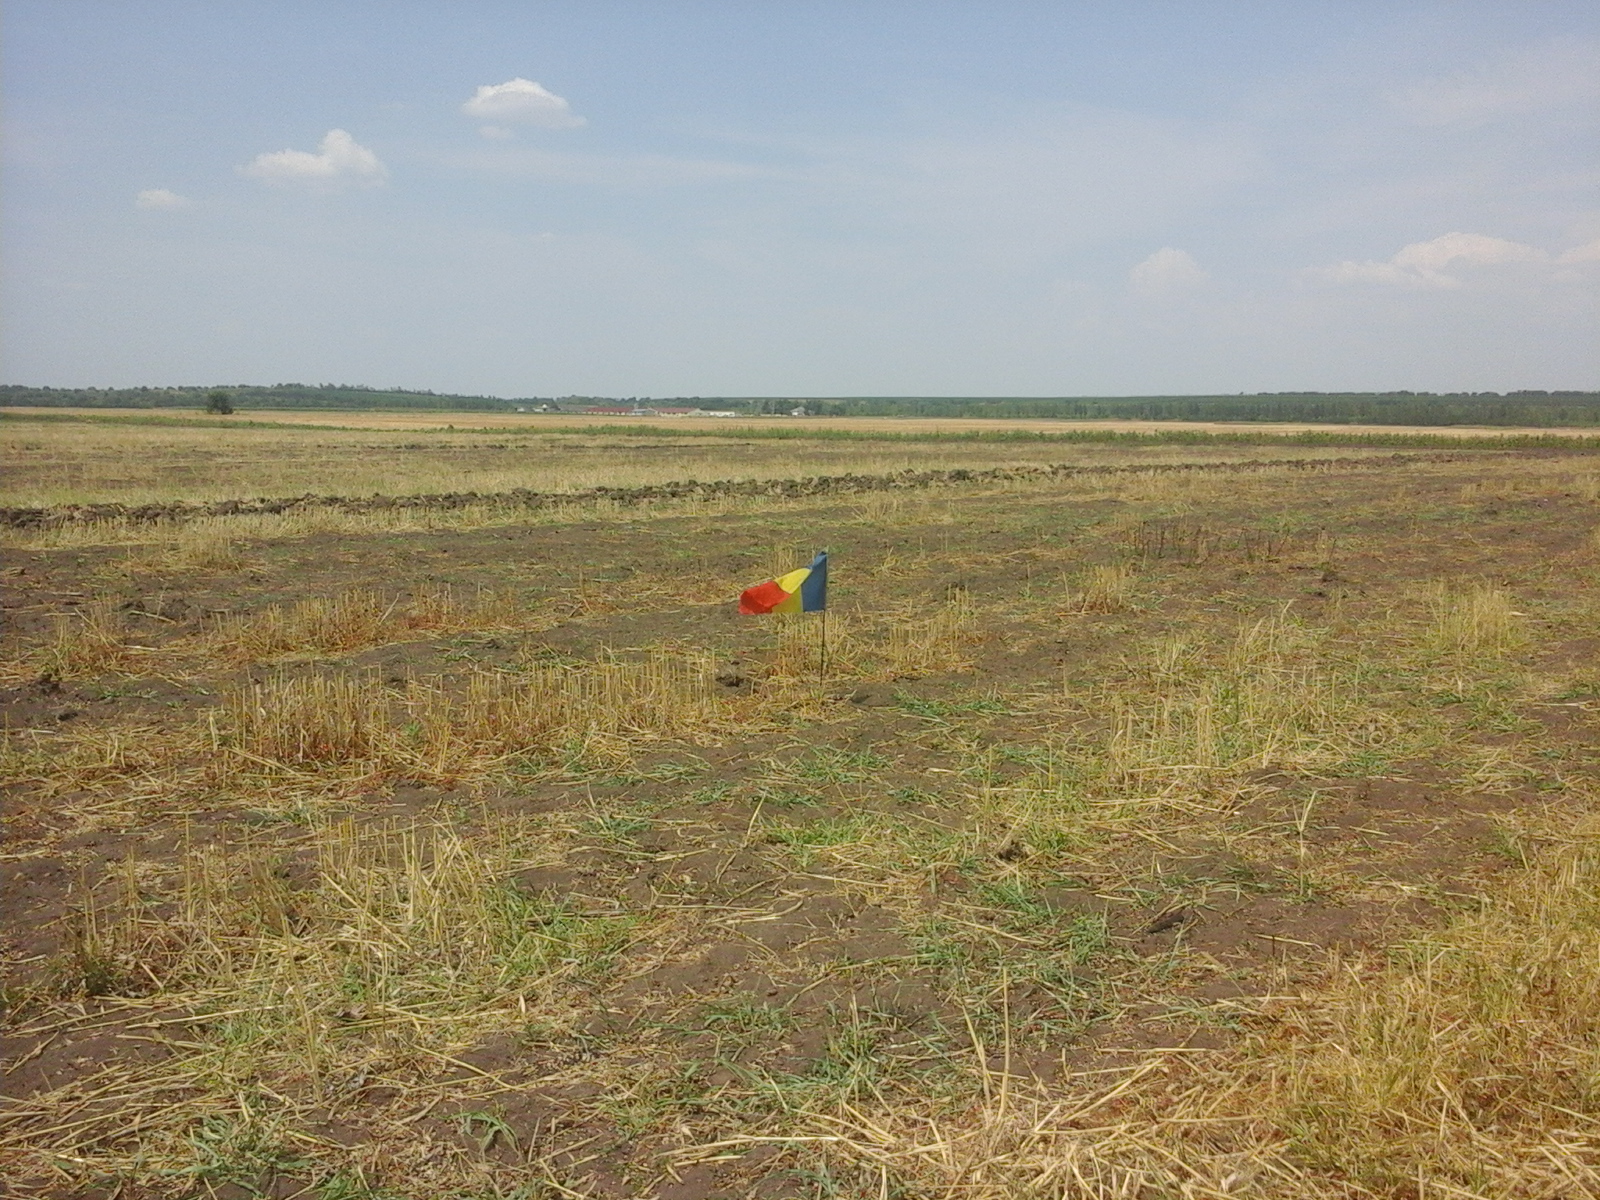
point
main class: Cropland
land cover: Common wheat
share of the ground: 25 - 50 %
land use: Agriculture (excluding fallow land and kitchen gardens)
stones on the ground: < 10 %
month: August
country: RO
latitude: 44.0941
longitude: 23.7055
